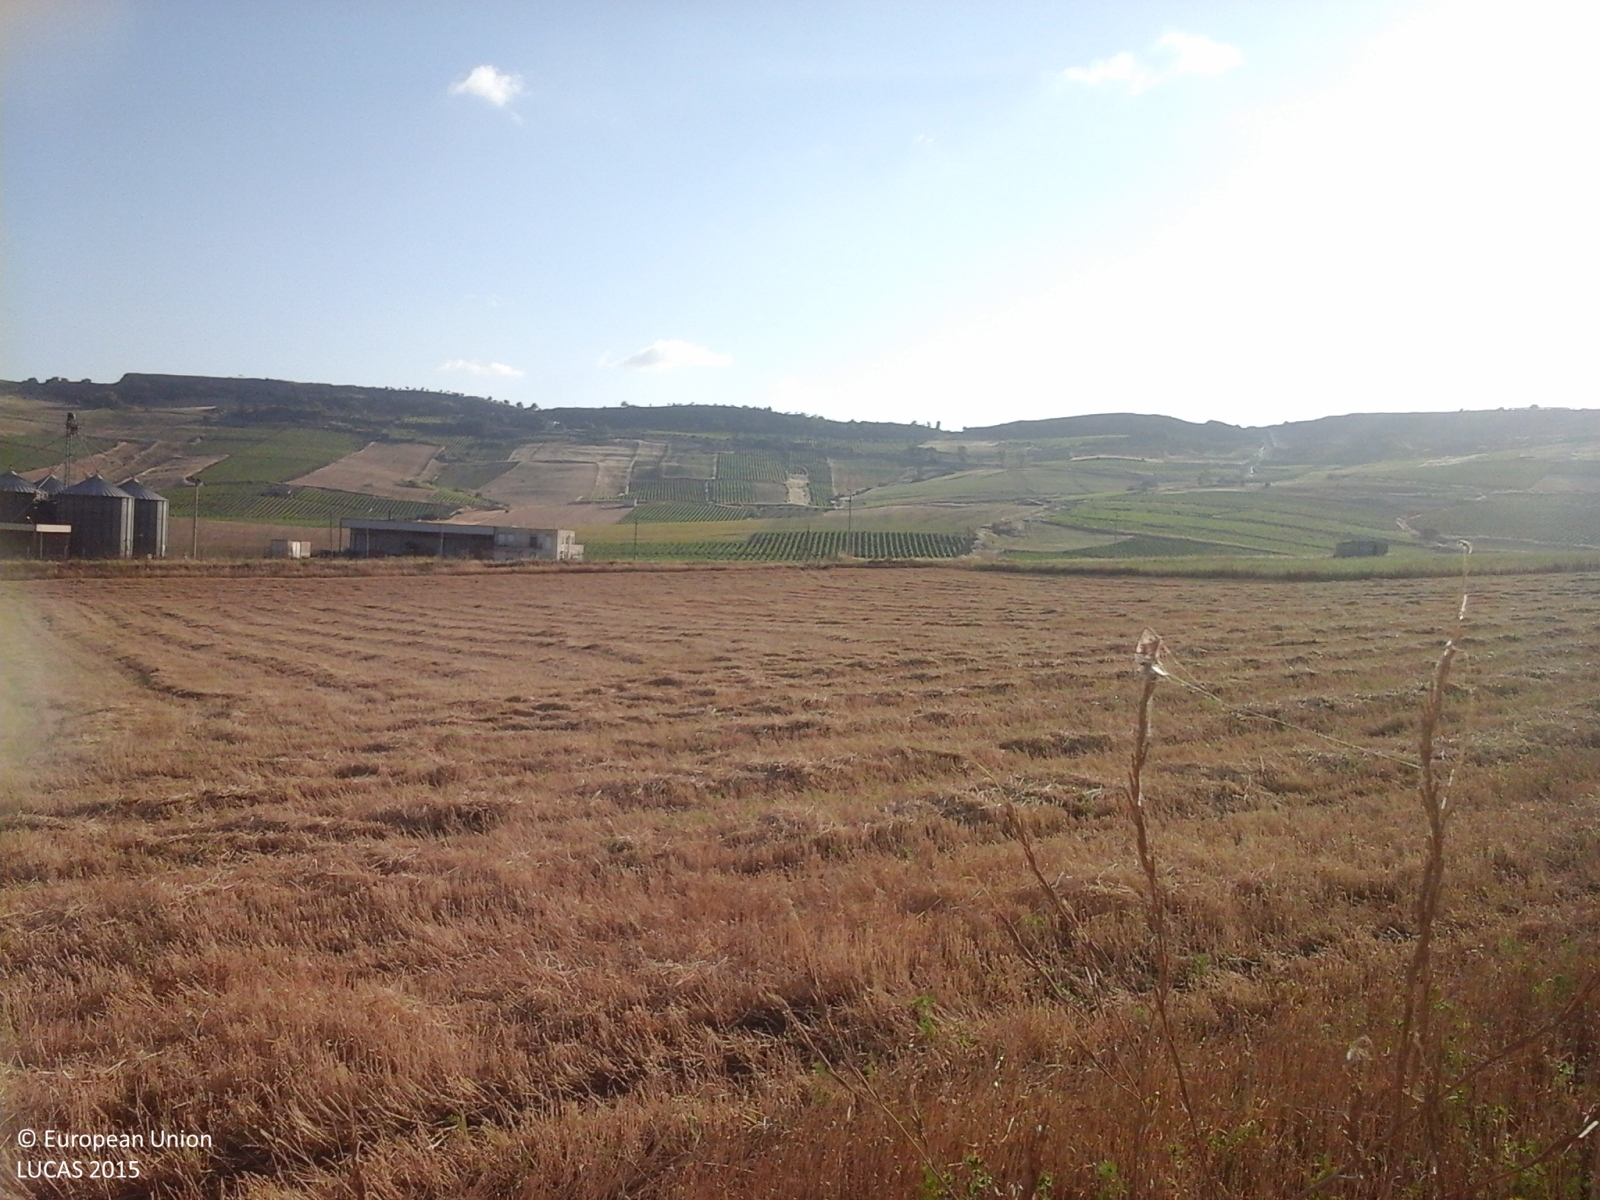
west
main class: Cropland
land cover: Durum wheat
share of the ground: > 75 %
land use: Agriculture (excluding fallow land and kitchen gardens)
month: June
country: IT
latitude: 37.6805
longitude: 13.0499
